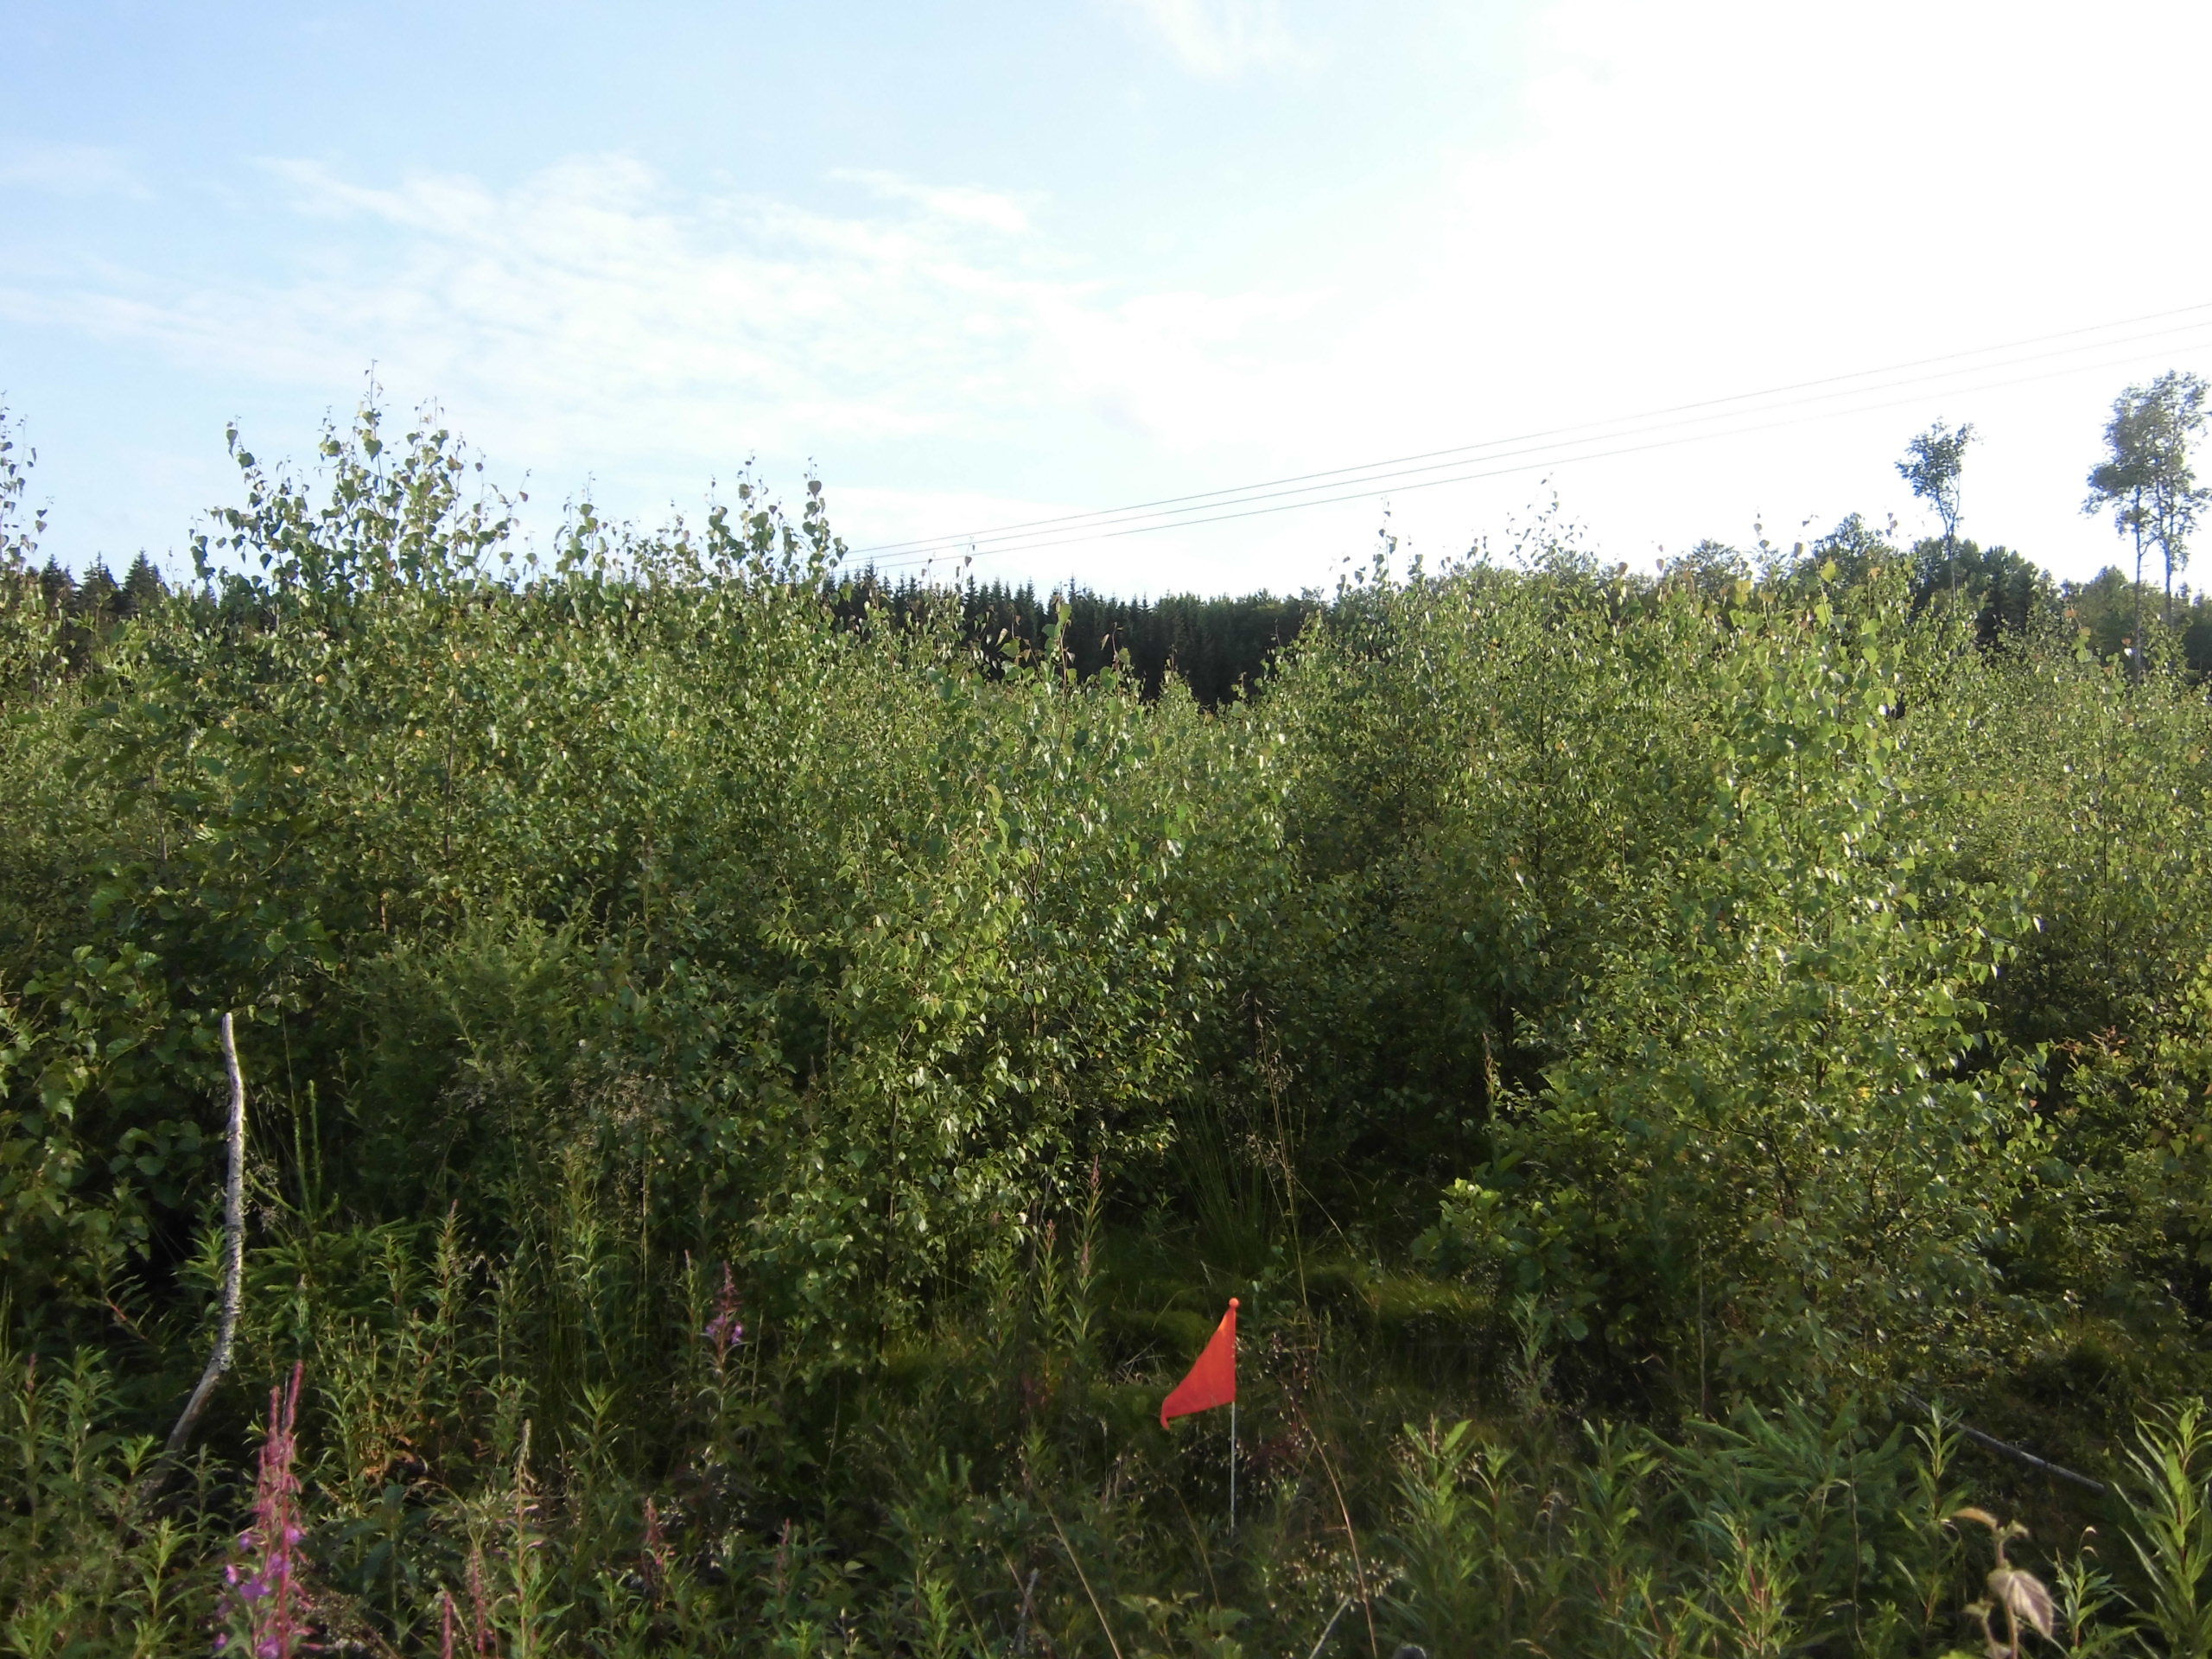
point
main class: Woodland
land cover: Broadleaved woodland
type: boreal forest
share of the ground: 50 - 75 %
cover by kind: broadleaved forest trees 65 %, herbaceous plants 20 %, coniferous forest trees 5 %, shrubs 5 %, lichens and mosses 5 %
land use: Forestry
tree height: < 5 m
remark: Clear cut
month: July
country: SE
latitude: 57.4833
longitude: 14.8497
